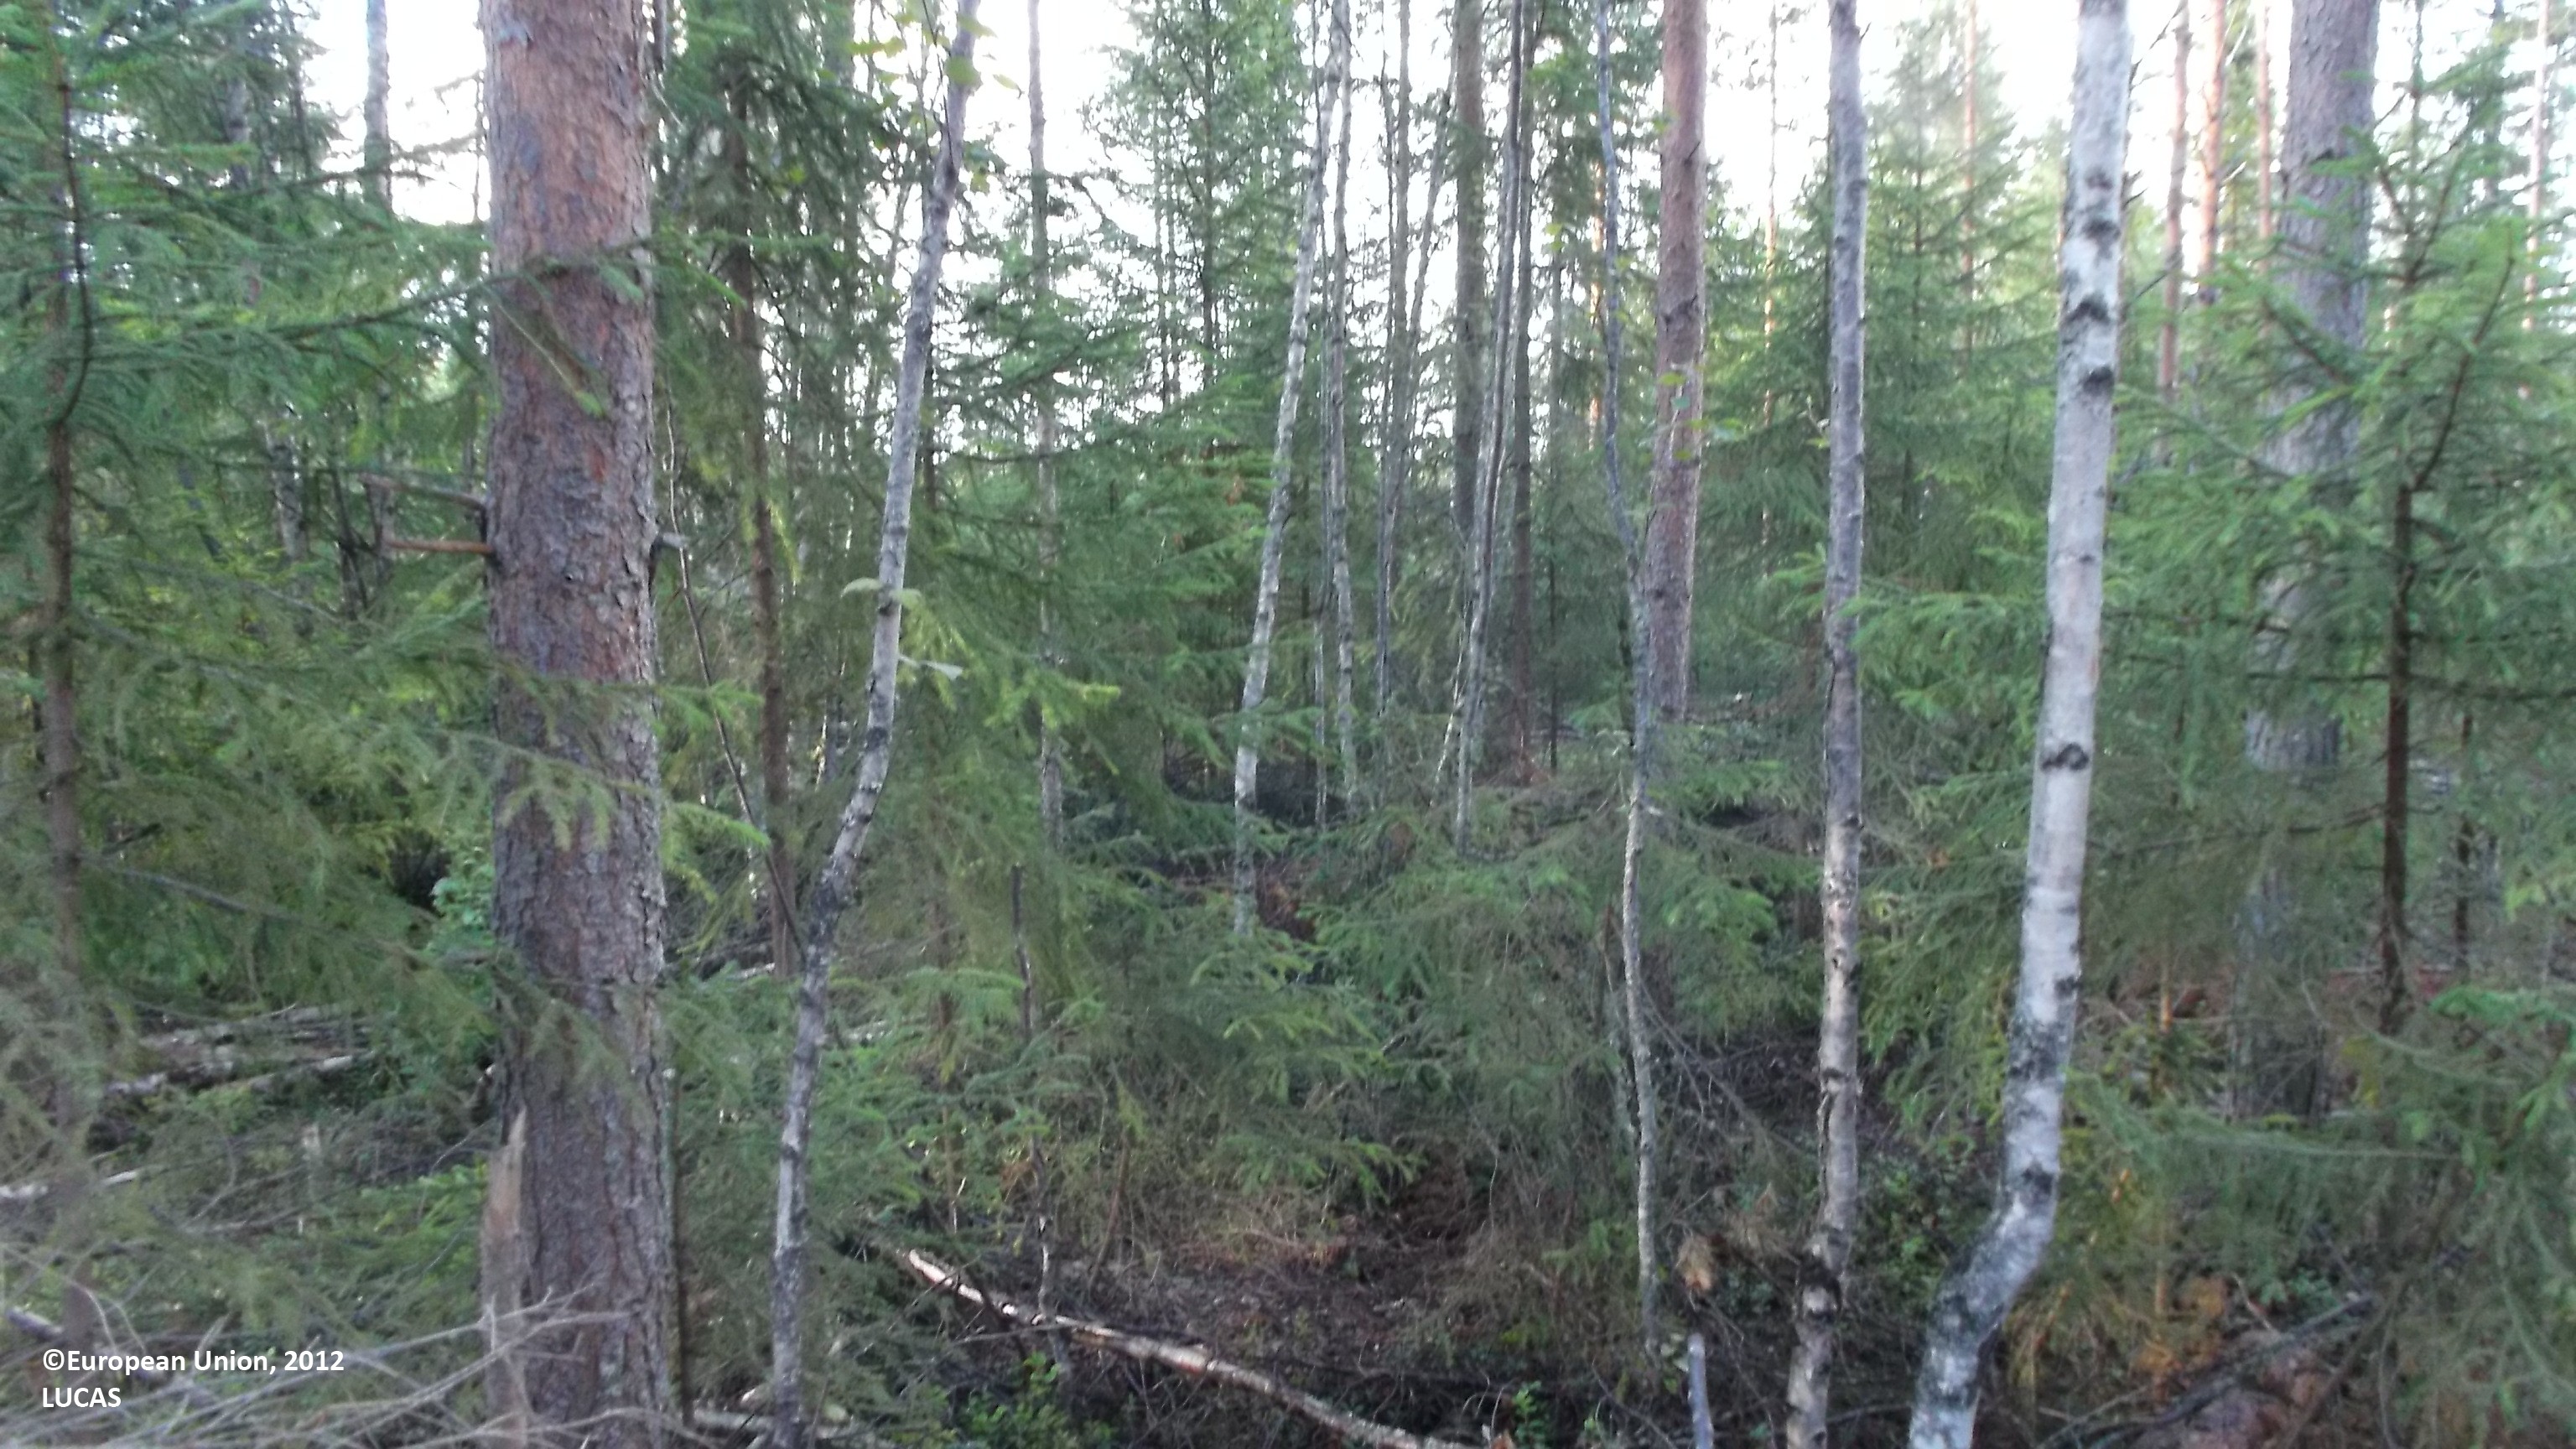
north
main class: Woodland
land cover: Pine dominated mixed woodland
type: boreal forest
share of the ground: 25 - 50 %
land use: Forestry
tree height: > 5 m
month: August
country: FI
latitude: 63.9246
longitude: 23.3296
